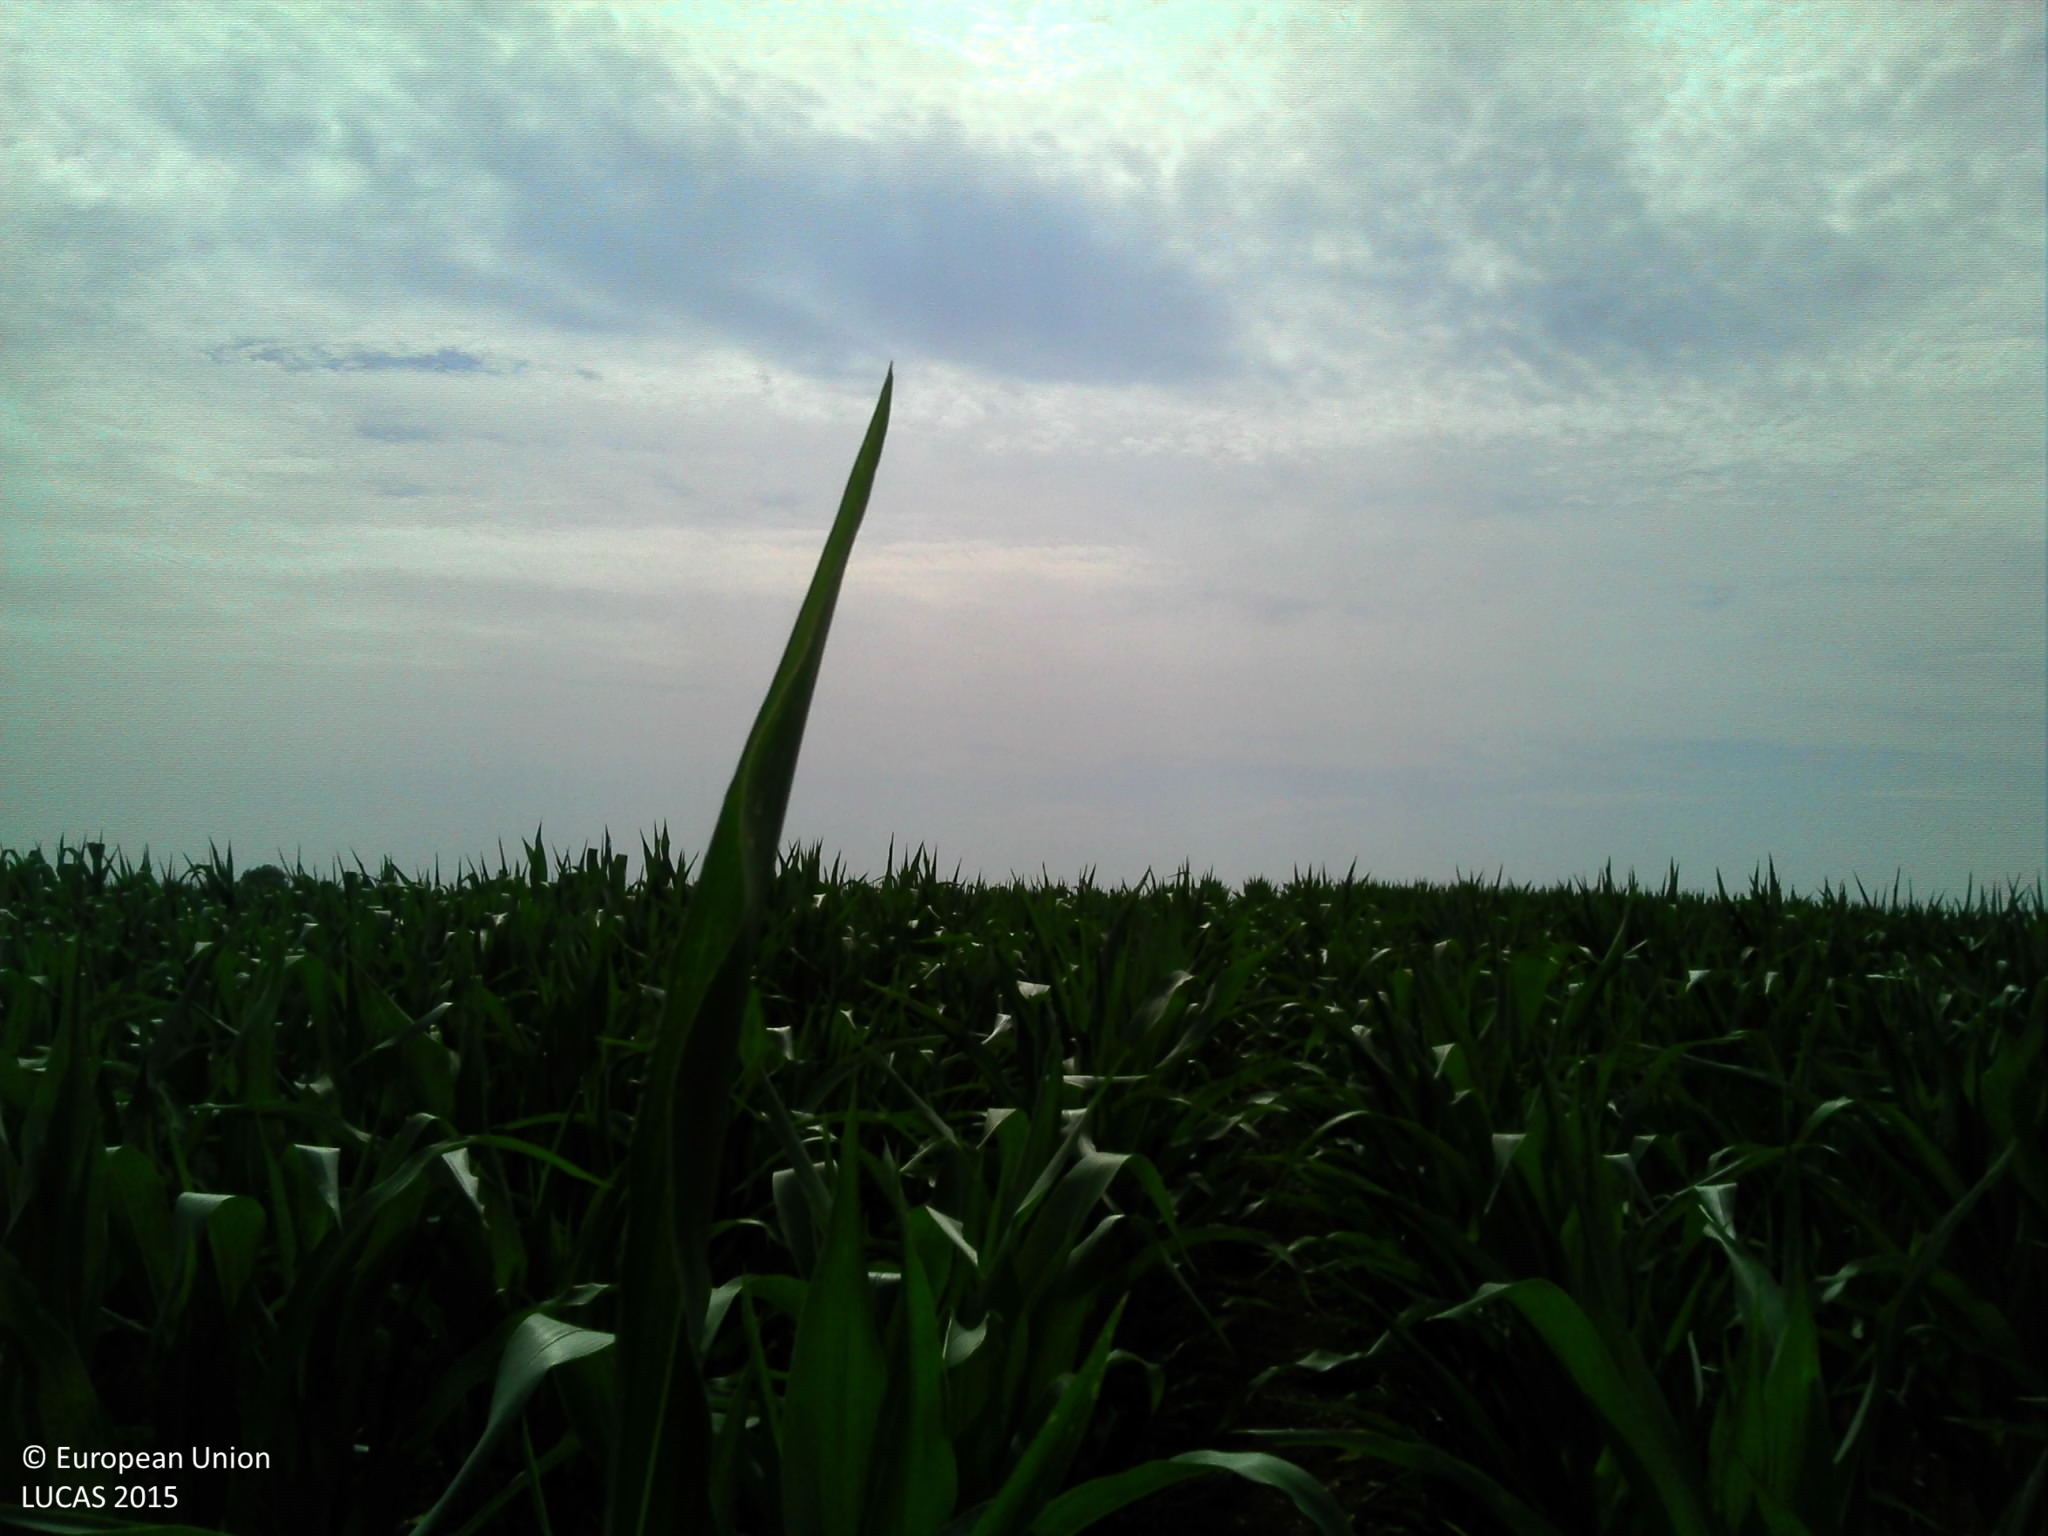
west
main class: Cropland
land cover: Maize
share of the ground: > 75 %
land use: Agriculture (excluding fallow land and kitchen gardens)
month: July
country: FR
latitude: 46.1578
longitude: 3.2785
